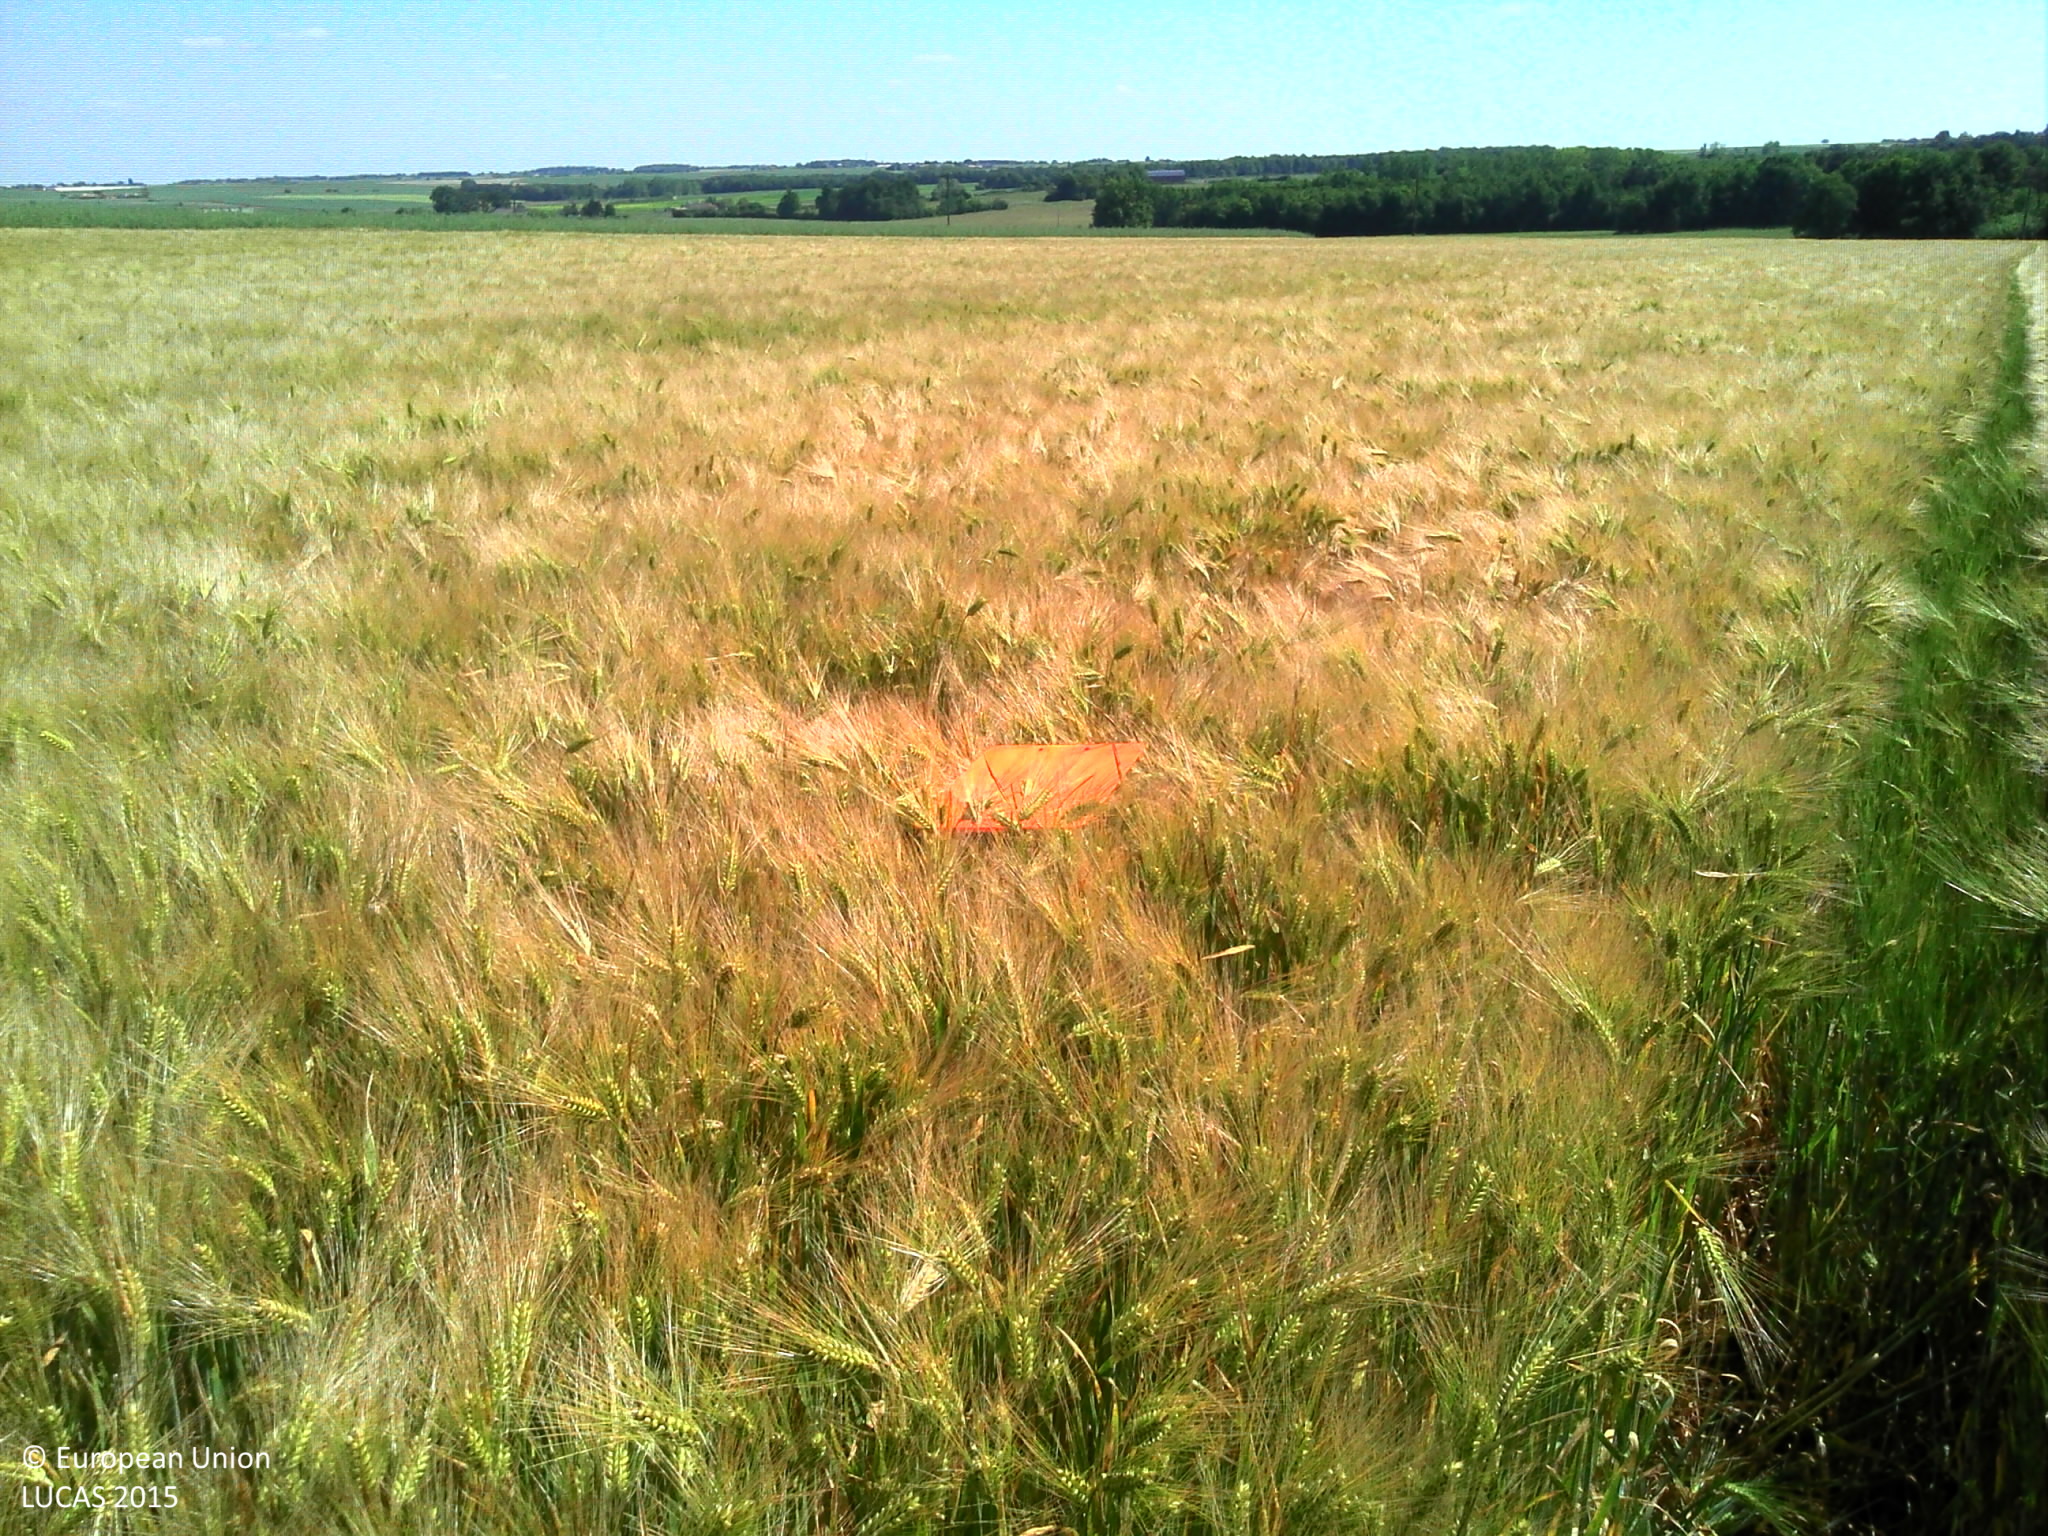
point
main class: Cropland
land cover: Barley
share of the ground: > 75 %
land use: Agriculture (excluding fallow land and kitchen gardens)
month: May
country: FR
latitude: 46.9891
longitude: 0.2087
